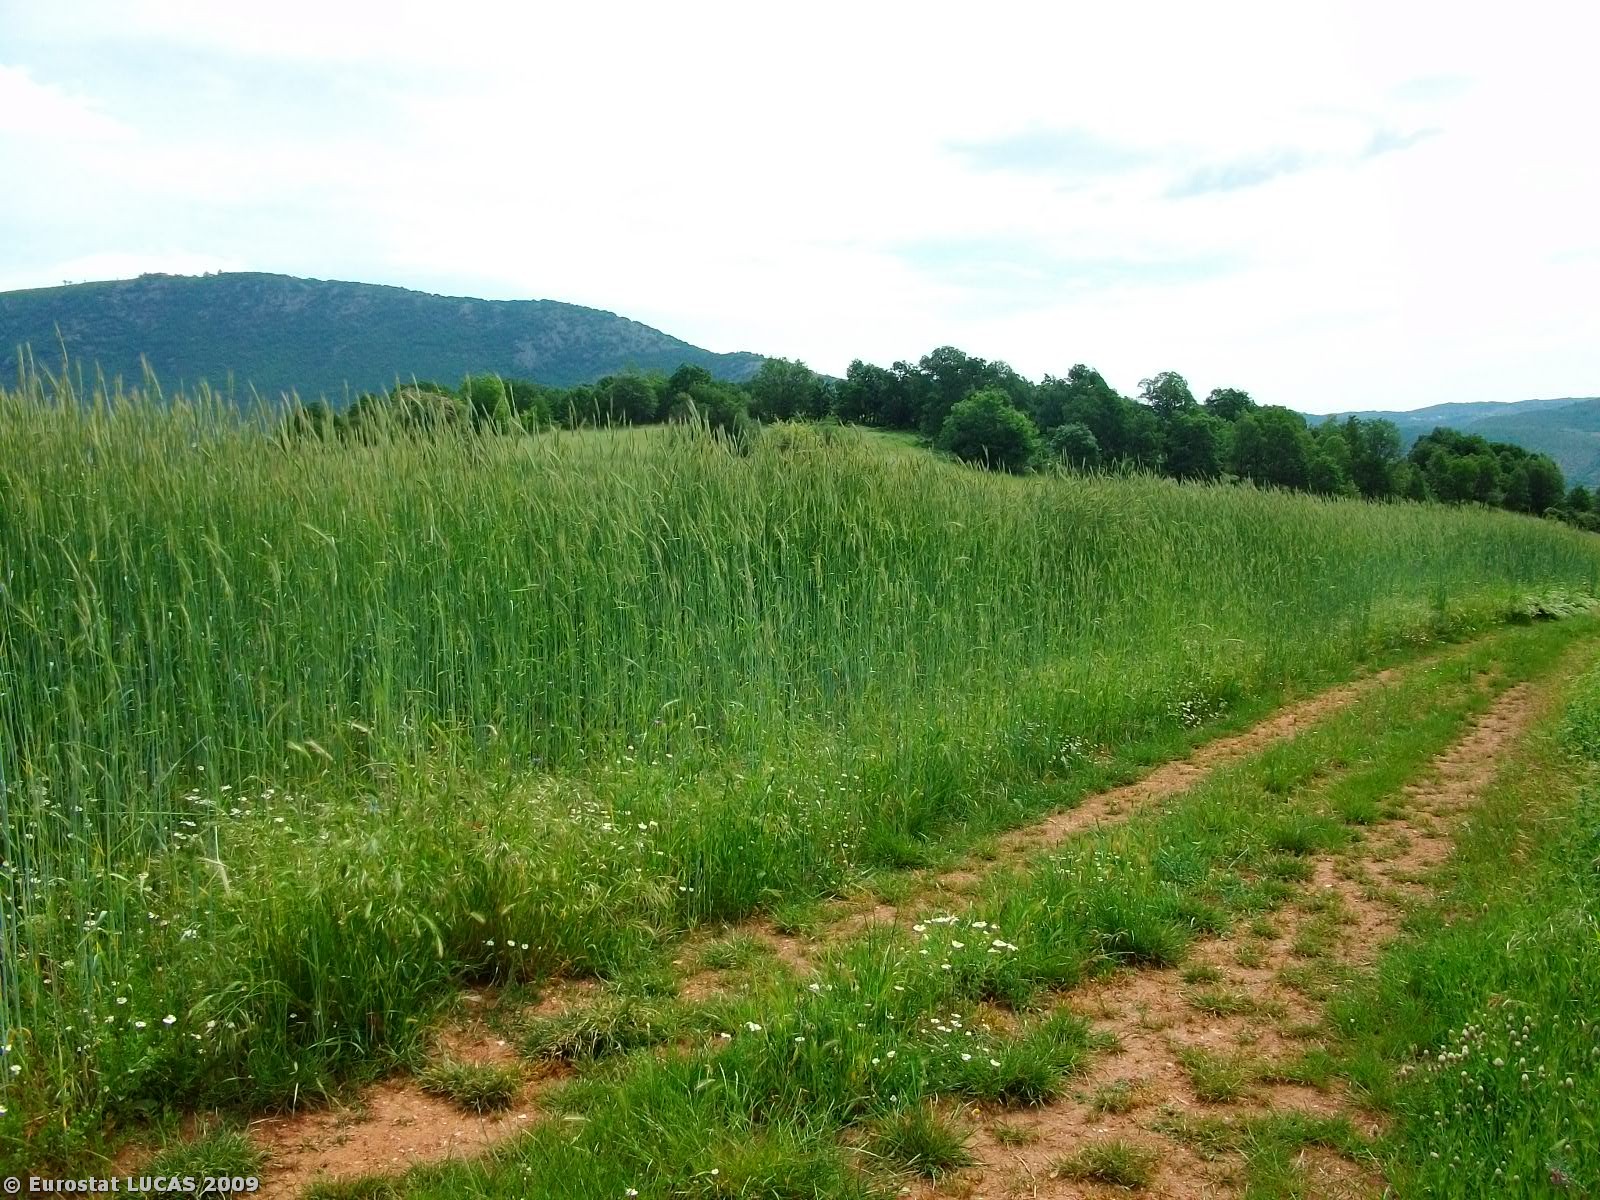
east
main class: Cropland
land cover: Barley
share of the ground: > 75 %
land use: Agriculture (excluding fallow land and kitchen gardens)
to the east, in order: Barley; Grass margins; Paved roads, cycling and walking lanes; Grass margins; Barley; Common wheat; Spontaneously vegetated surfaces; Grassland with sparse tree/shrub cover; Common wheat
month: May
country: GR
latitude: 40.7128
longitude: 21.8697
